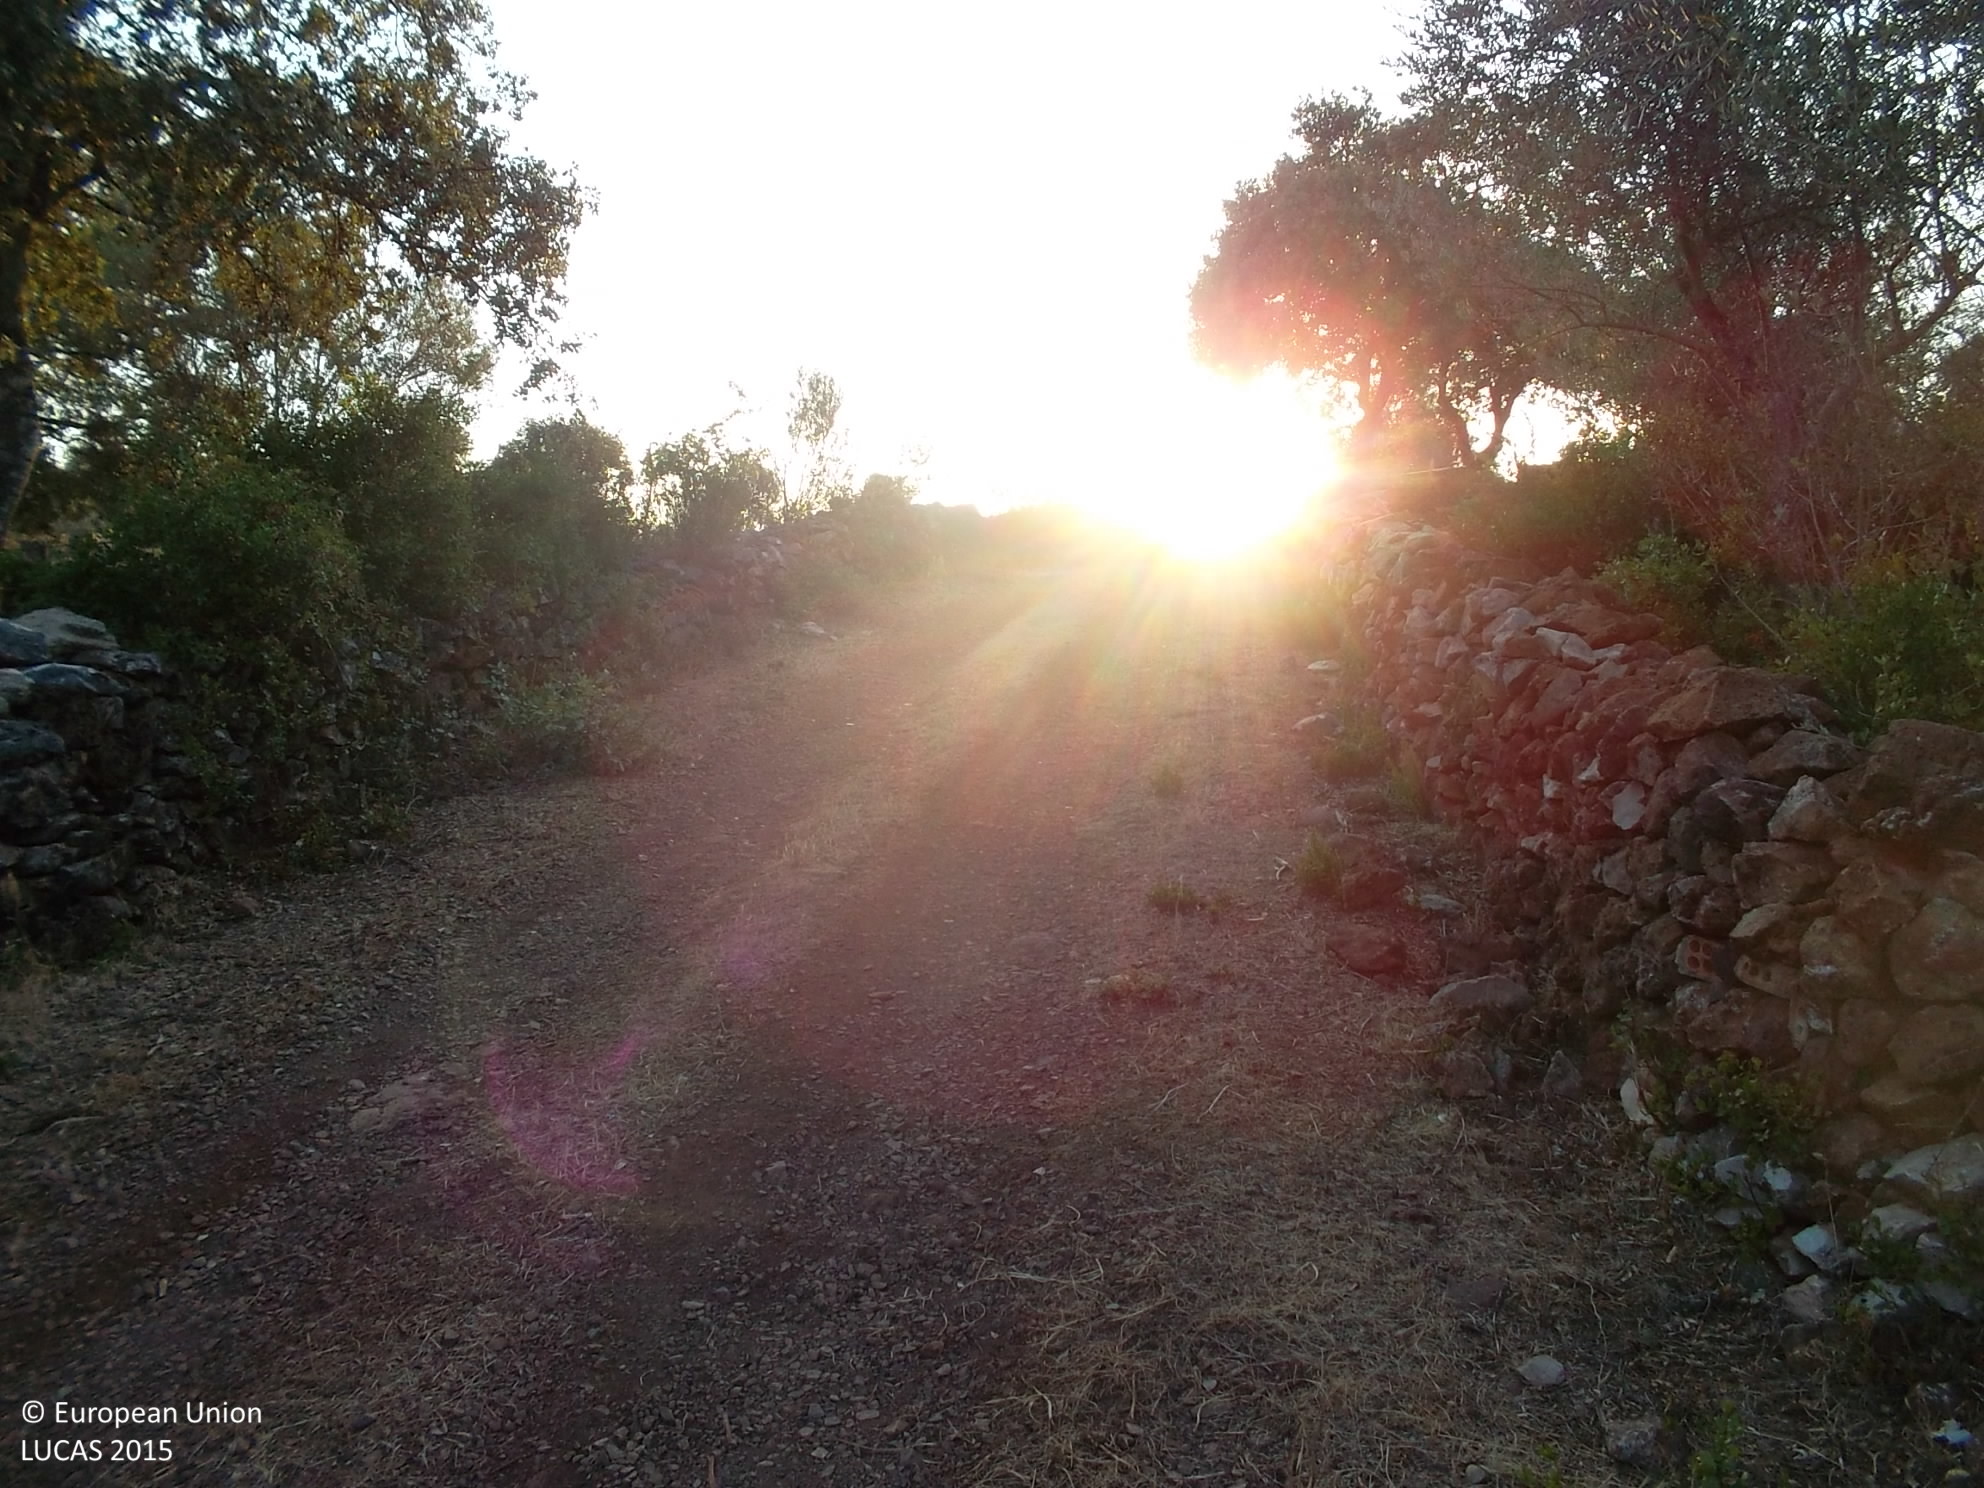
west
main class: Cropland
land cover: Olive groves
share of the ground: 25 - 50 %
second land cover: Shrubland without tree cover
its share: > 75 %
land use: Abandoned areas
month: September
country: ES
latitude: 38.0209
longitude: -6.5514
